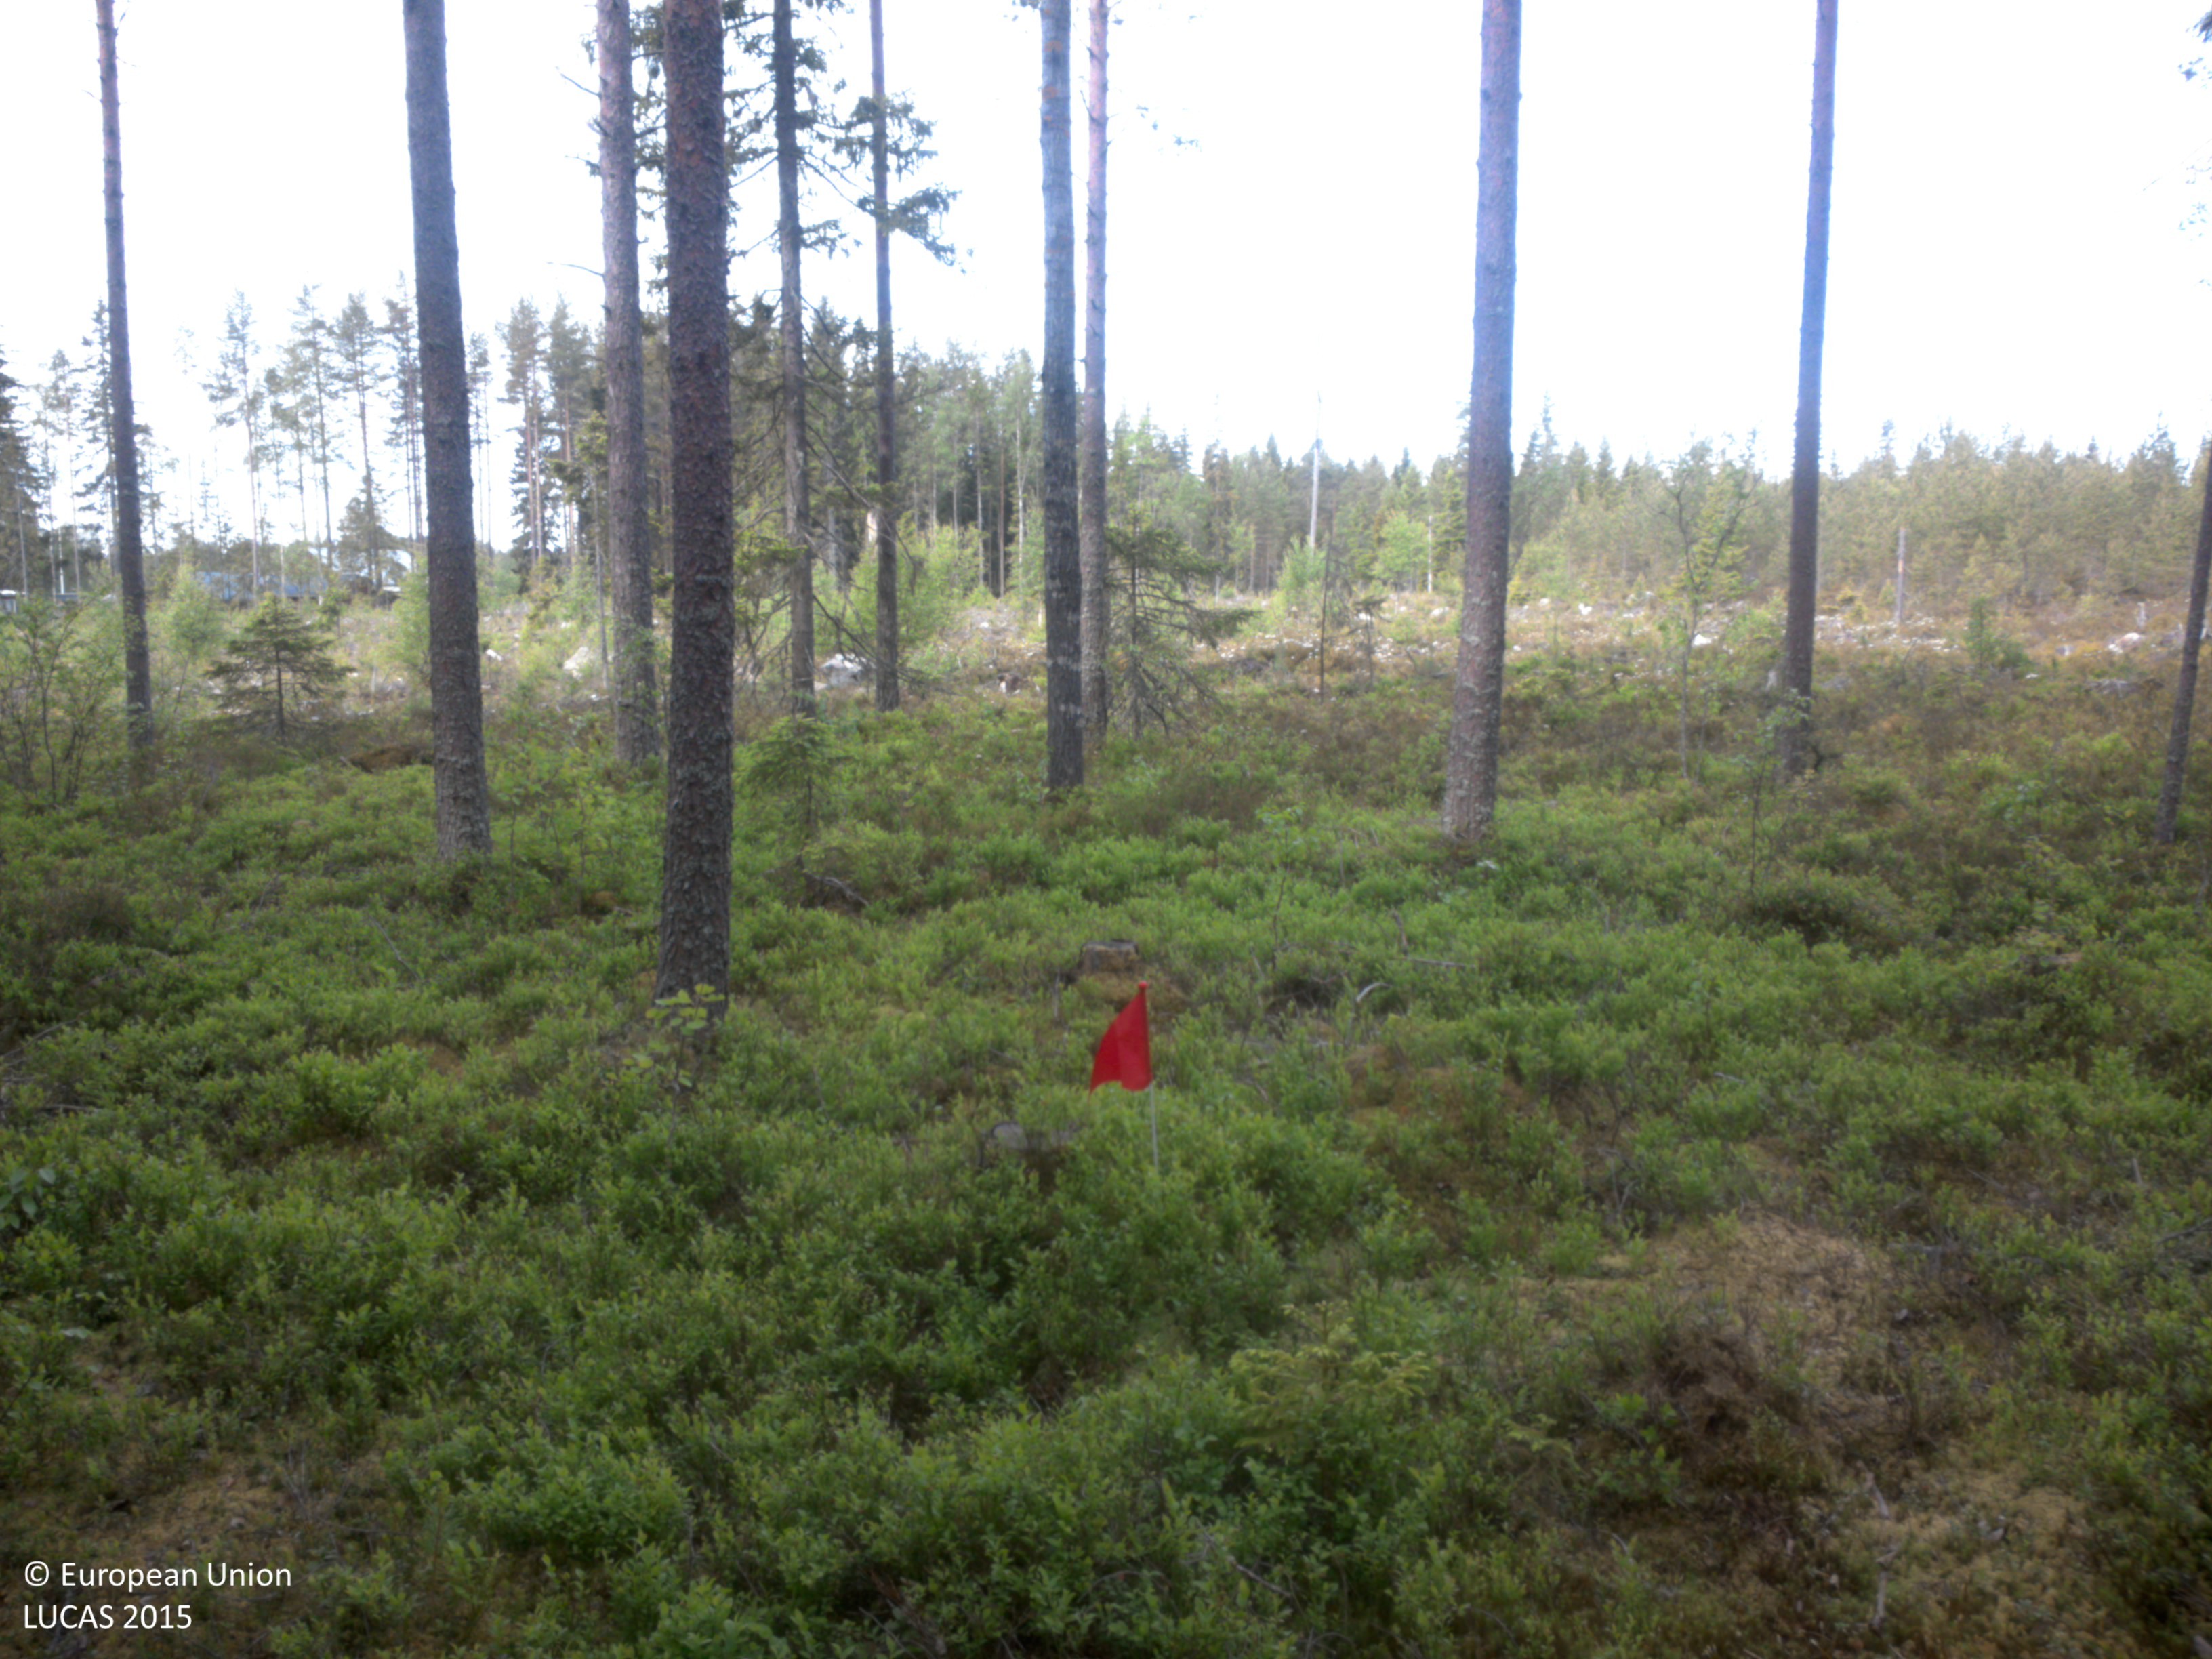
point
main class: Woodland
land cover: Pine dominated coniferous woodland
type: boreal forest
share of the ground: 25 - 50 %
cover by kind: shrubs 50 %, coniferous forest trees 40 %, herbaceous plants 10 %
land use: Forestry
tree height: > 5 m
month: June
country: SE
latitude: 63.5671
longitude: 19.7869
